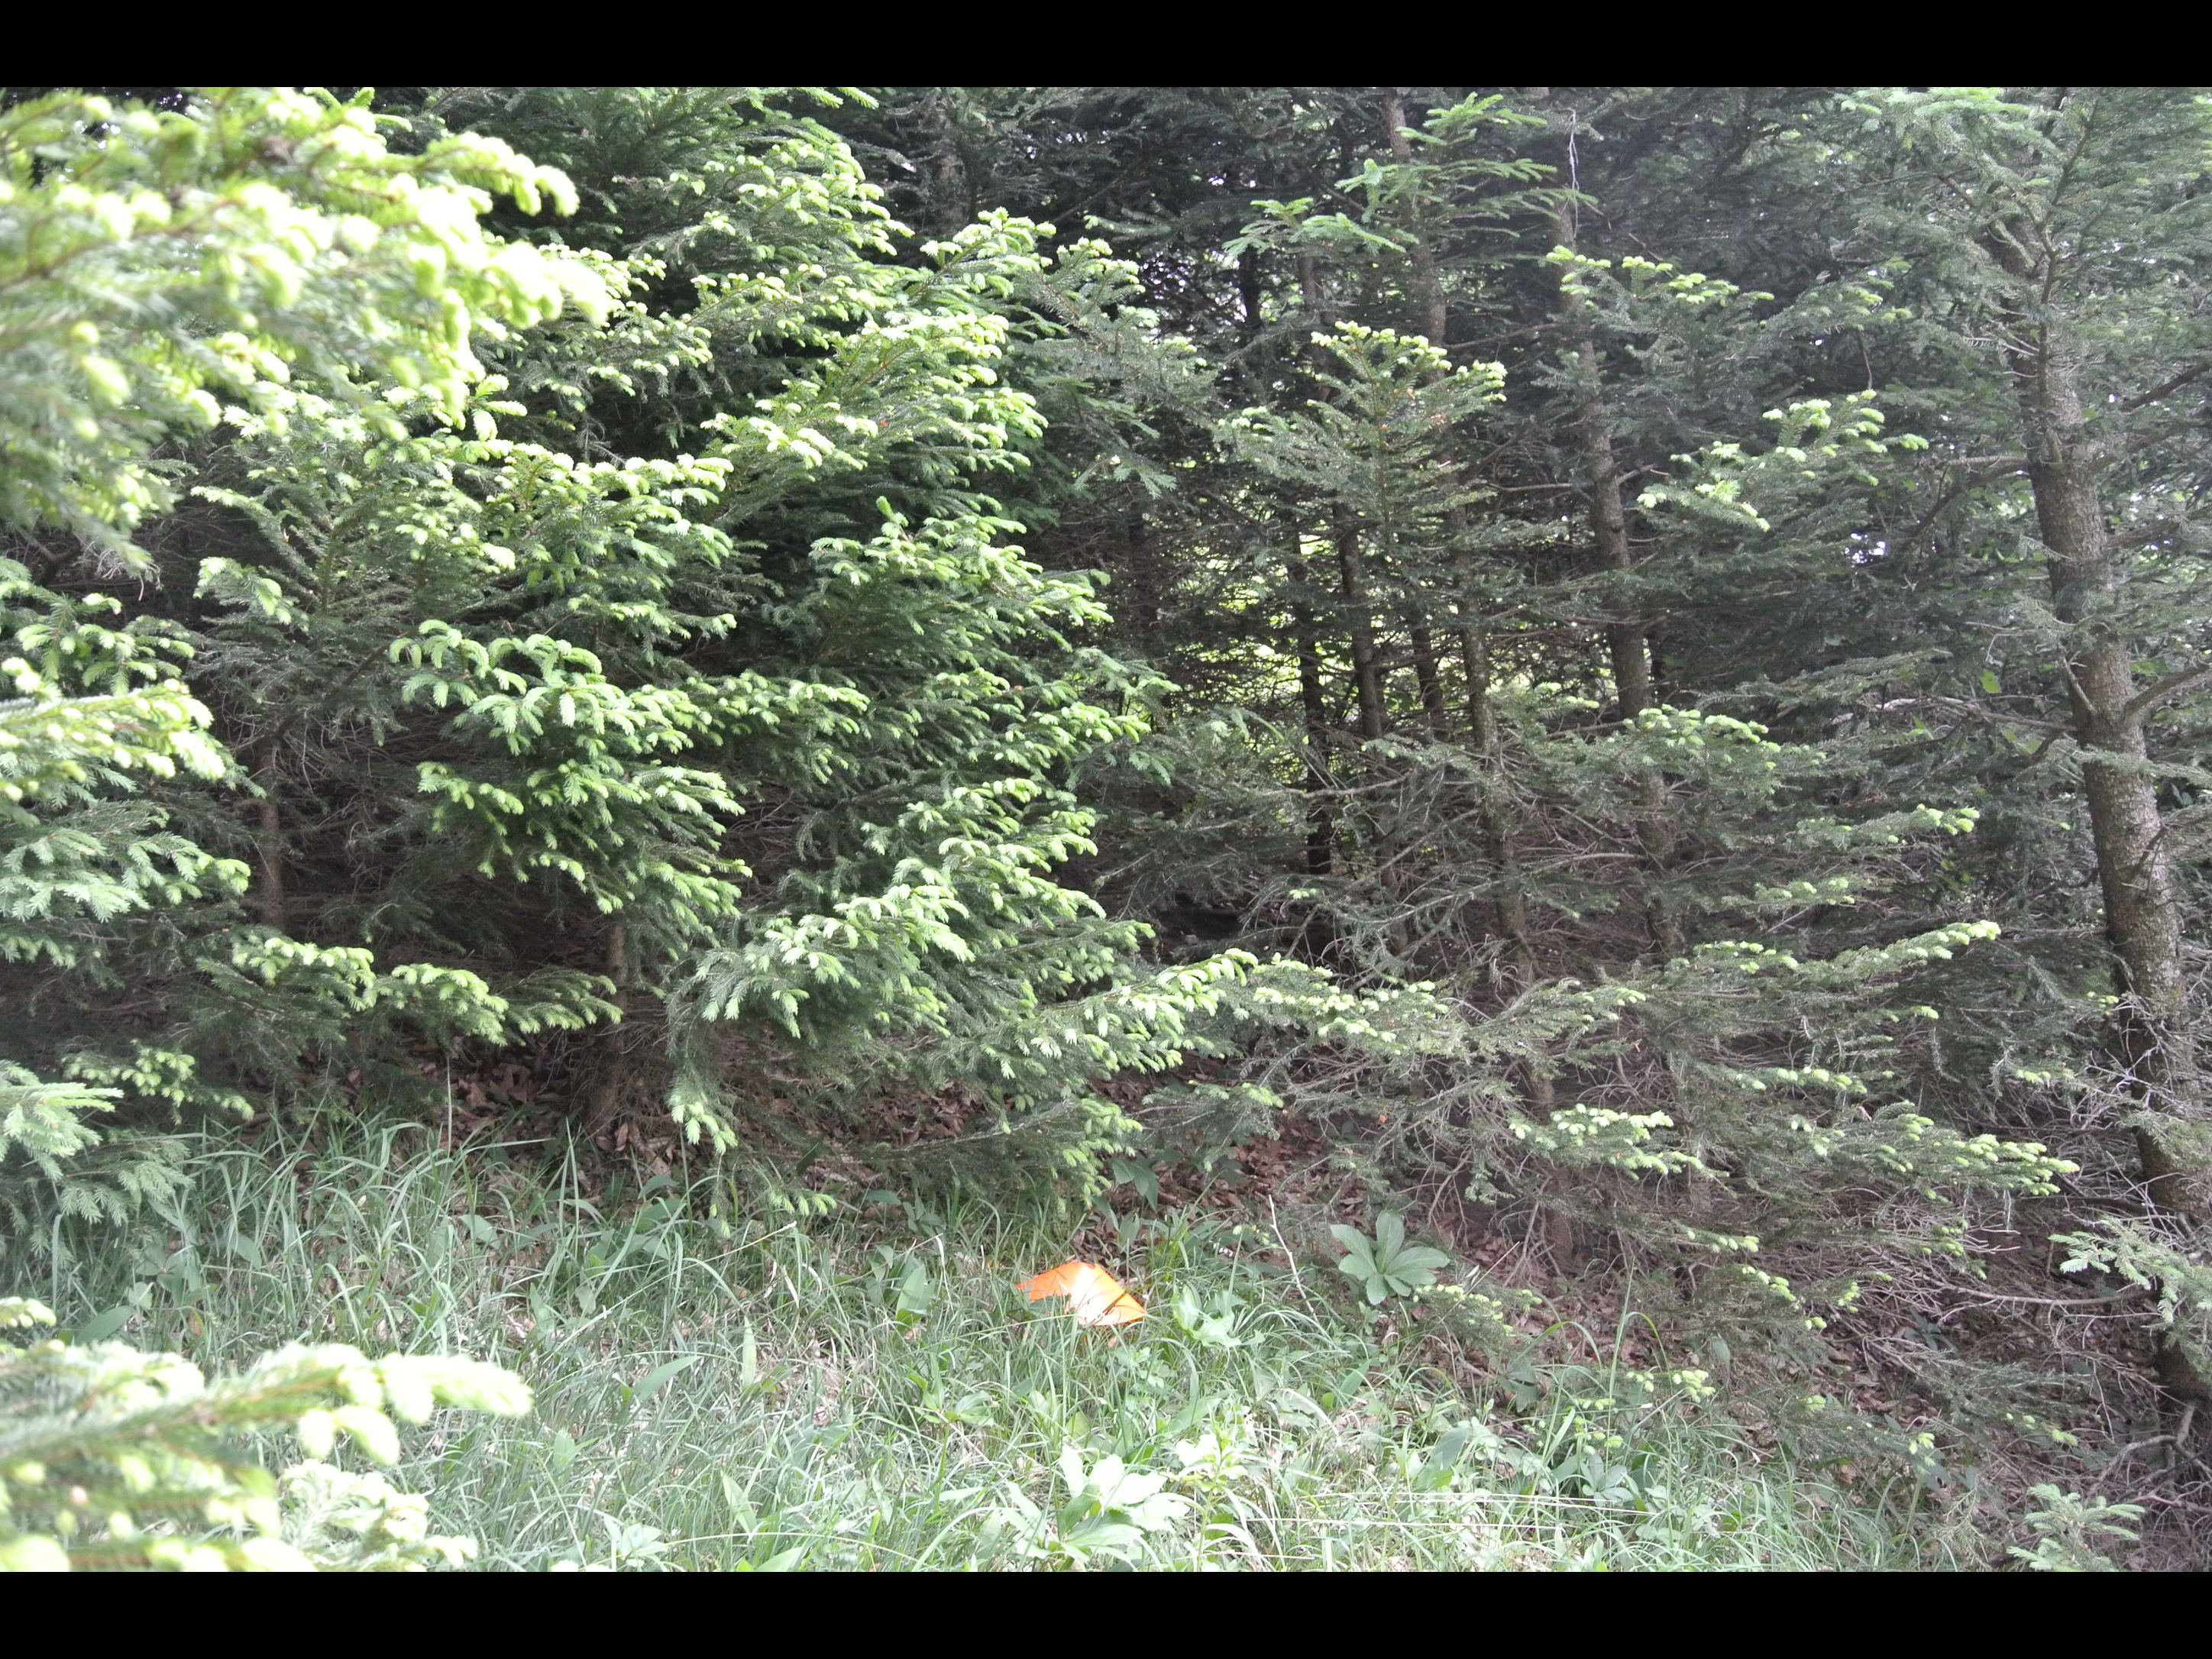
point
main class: Woodland
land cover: Spruce dominated coniferous woodland
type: alpine coniferous forest
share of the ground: > 75 %
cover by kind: coniferous forest trees 90 %, herbaceous plants 10 %
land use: Forestry
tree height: > 5 m
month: June
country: AT
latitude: 47.9281
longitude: 15.7710
